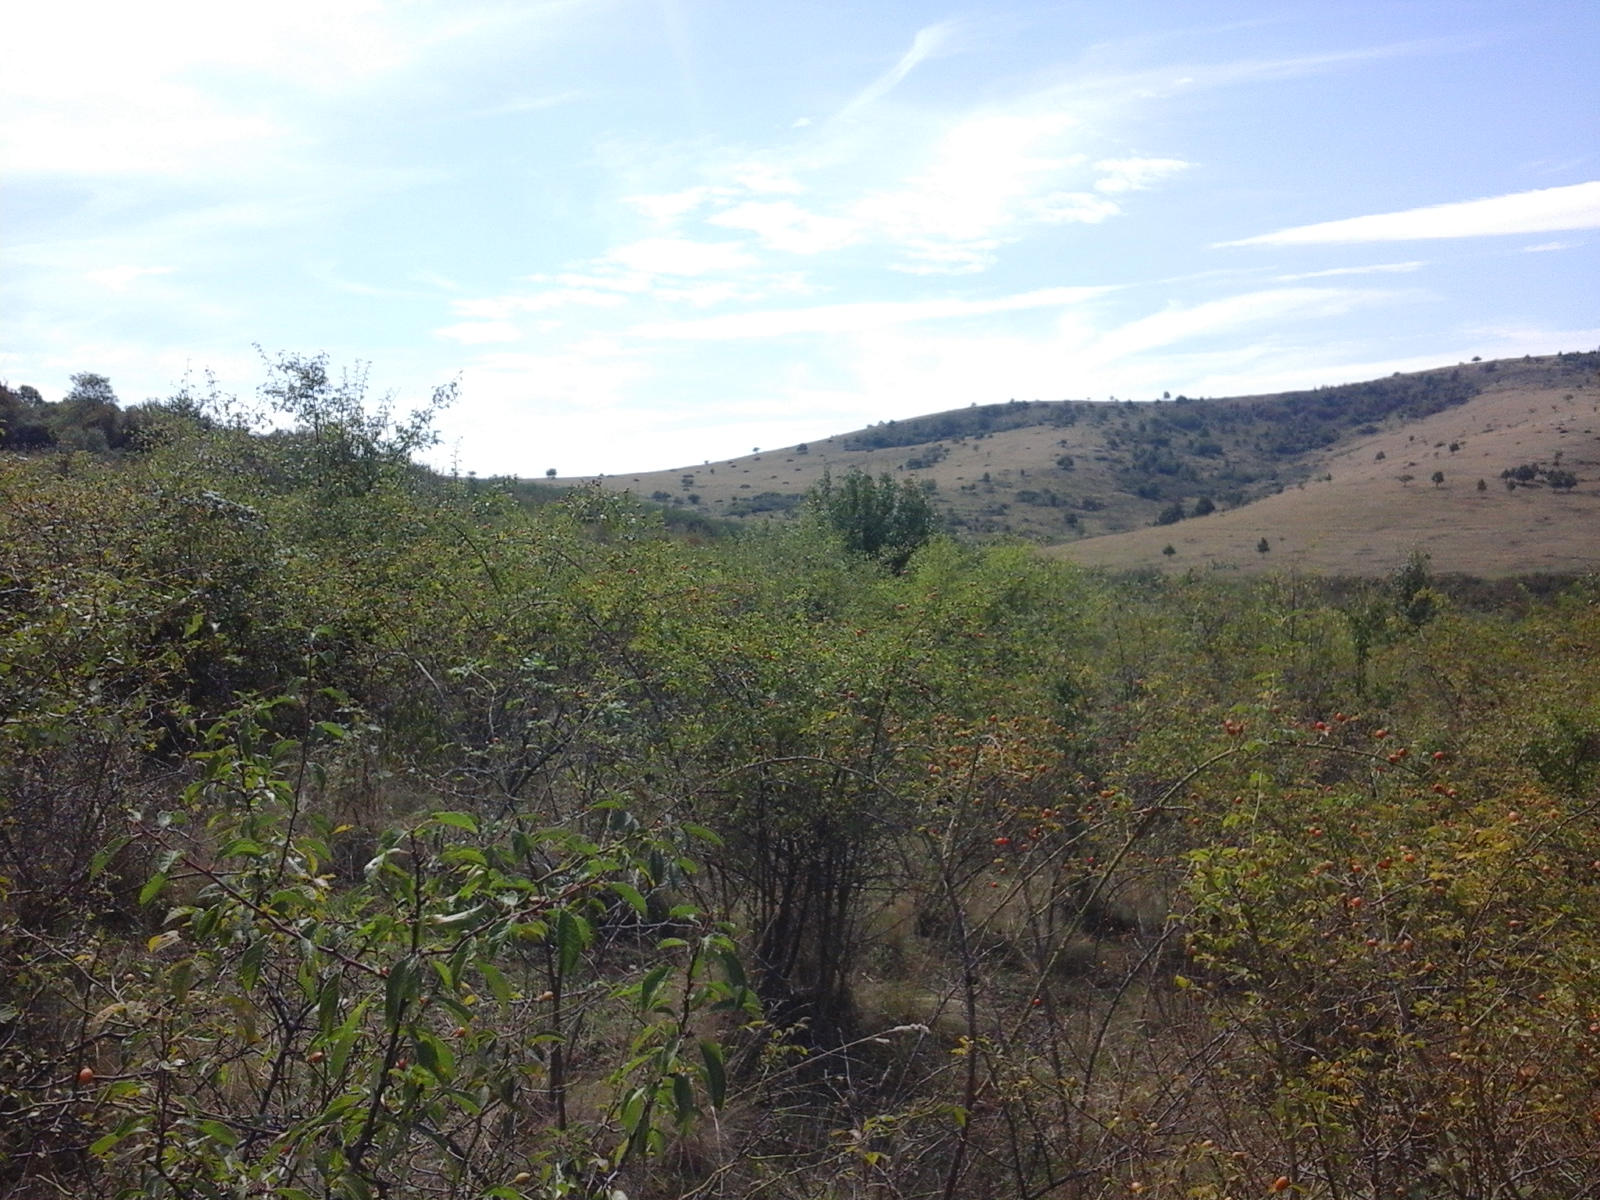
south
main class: Shrubland
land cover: Shrubland without tree cover
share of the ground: > 75 %
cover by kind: shrubs 100 %
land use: Fallow land
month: August
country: RO
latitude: 46.2851
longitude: 21.7339
